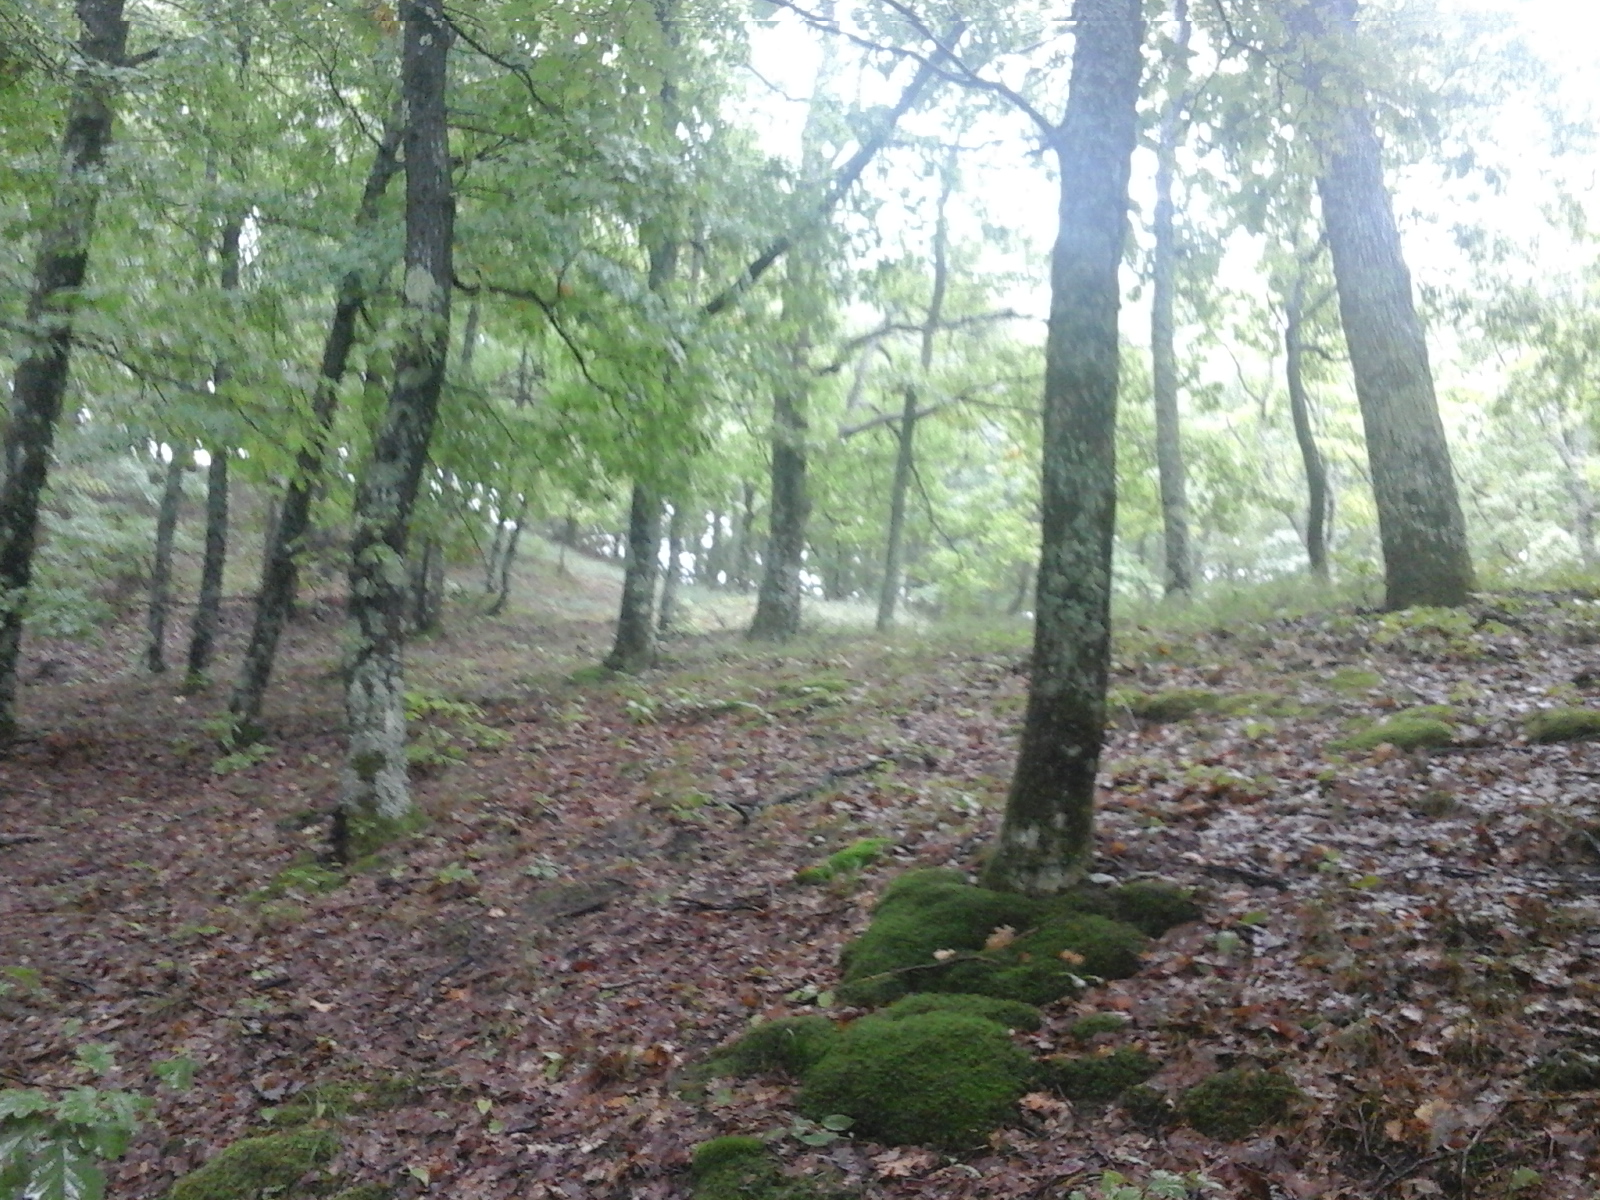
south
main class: Woodland
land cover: Broadleaved woodland
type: acidophilous oak and oak-birch forest
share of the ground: > 75 %
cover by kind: broadleaved forest trees 100 %
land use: Forestry
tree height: > 5 m
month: September
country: RO
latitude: 44.9308
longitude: 23.7323
